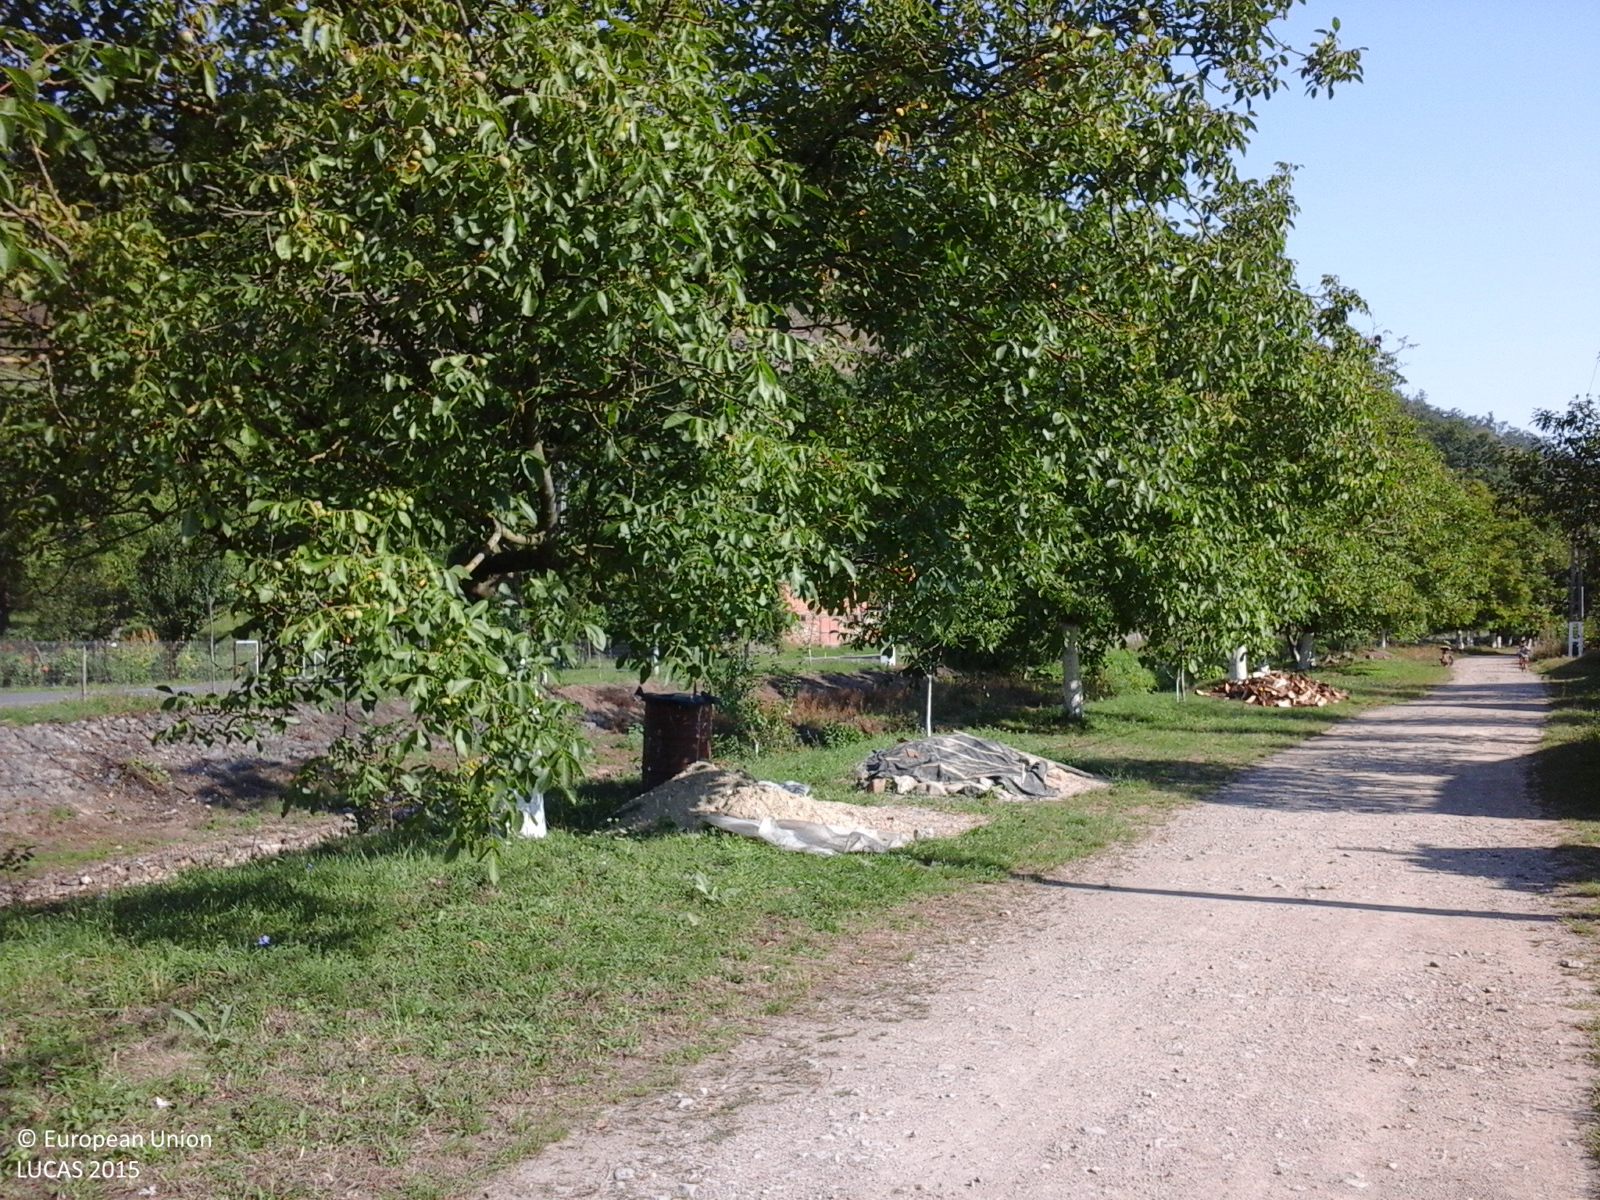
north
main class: Cropland
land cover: Other fruit trees and berries
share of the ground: 25 - 50 %
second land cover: Grassland without tree/shrub cover
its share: > 75 %
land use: Agriculture (excluding fallow land and kitchen gardens)
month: August
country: RO
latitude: 46.2182
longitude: 22.3237
